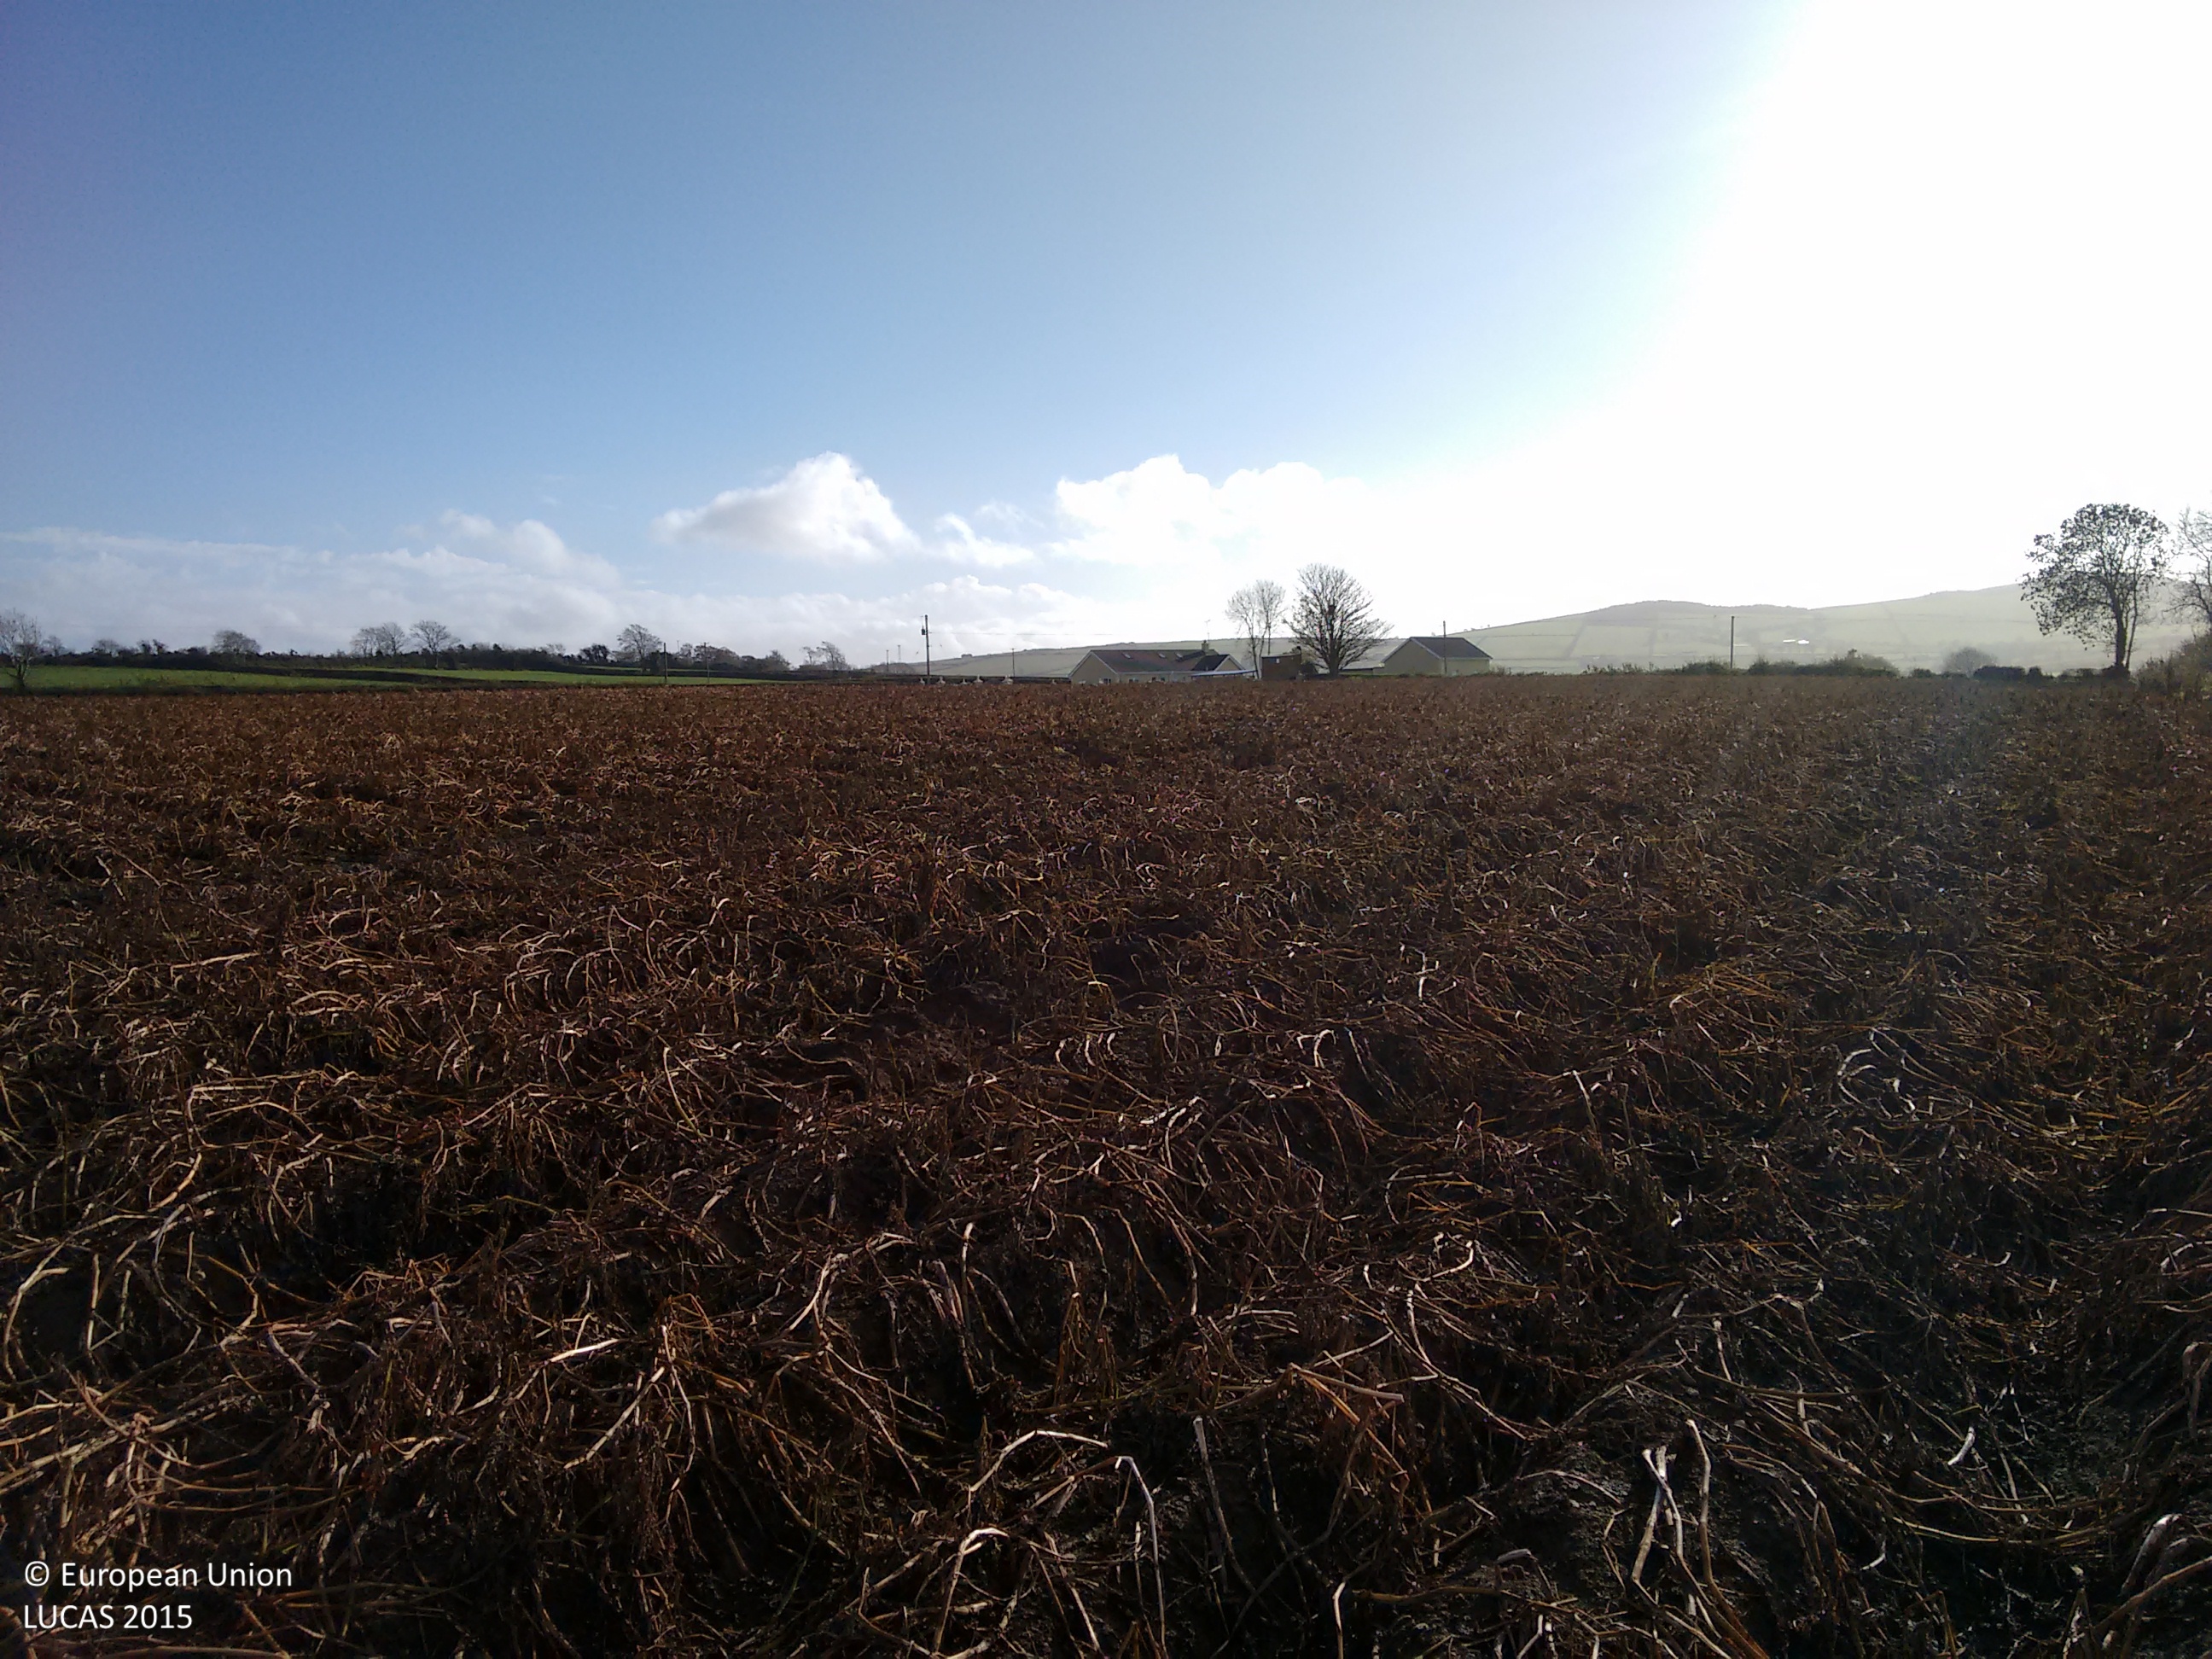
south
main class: Cropland
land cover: Potatoes
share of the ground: 10 - 25 %
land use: Agriculture (excluding fallow land and kitchen gardens)
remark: Harvested field
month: November
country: IE
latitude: 54.8562
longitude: -7.5241
